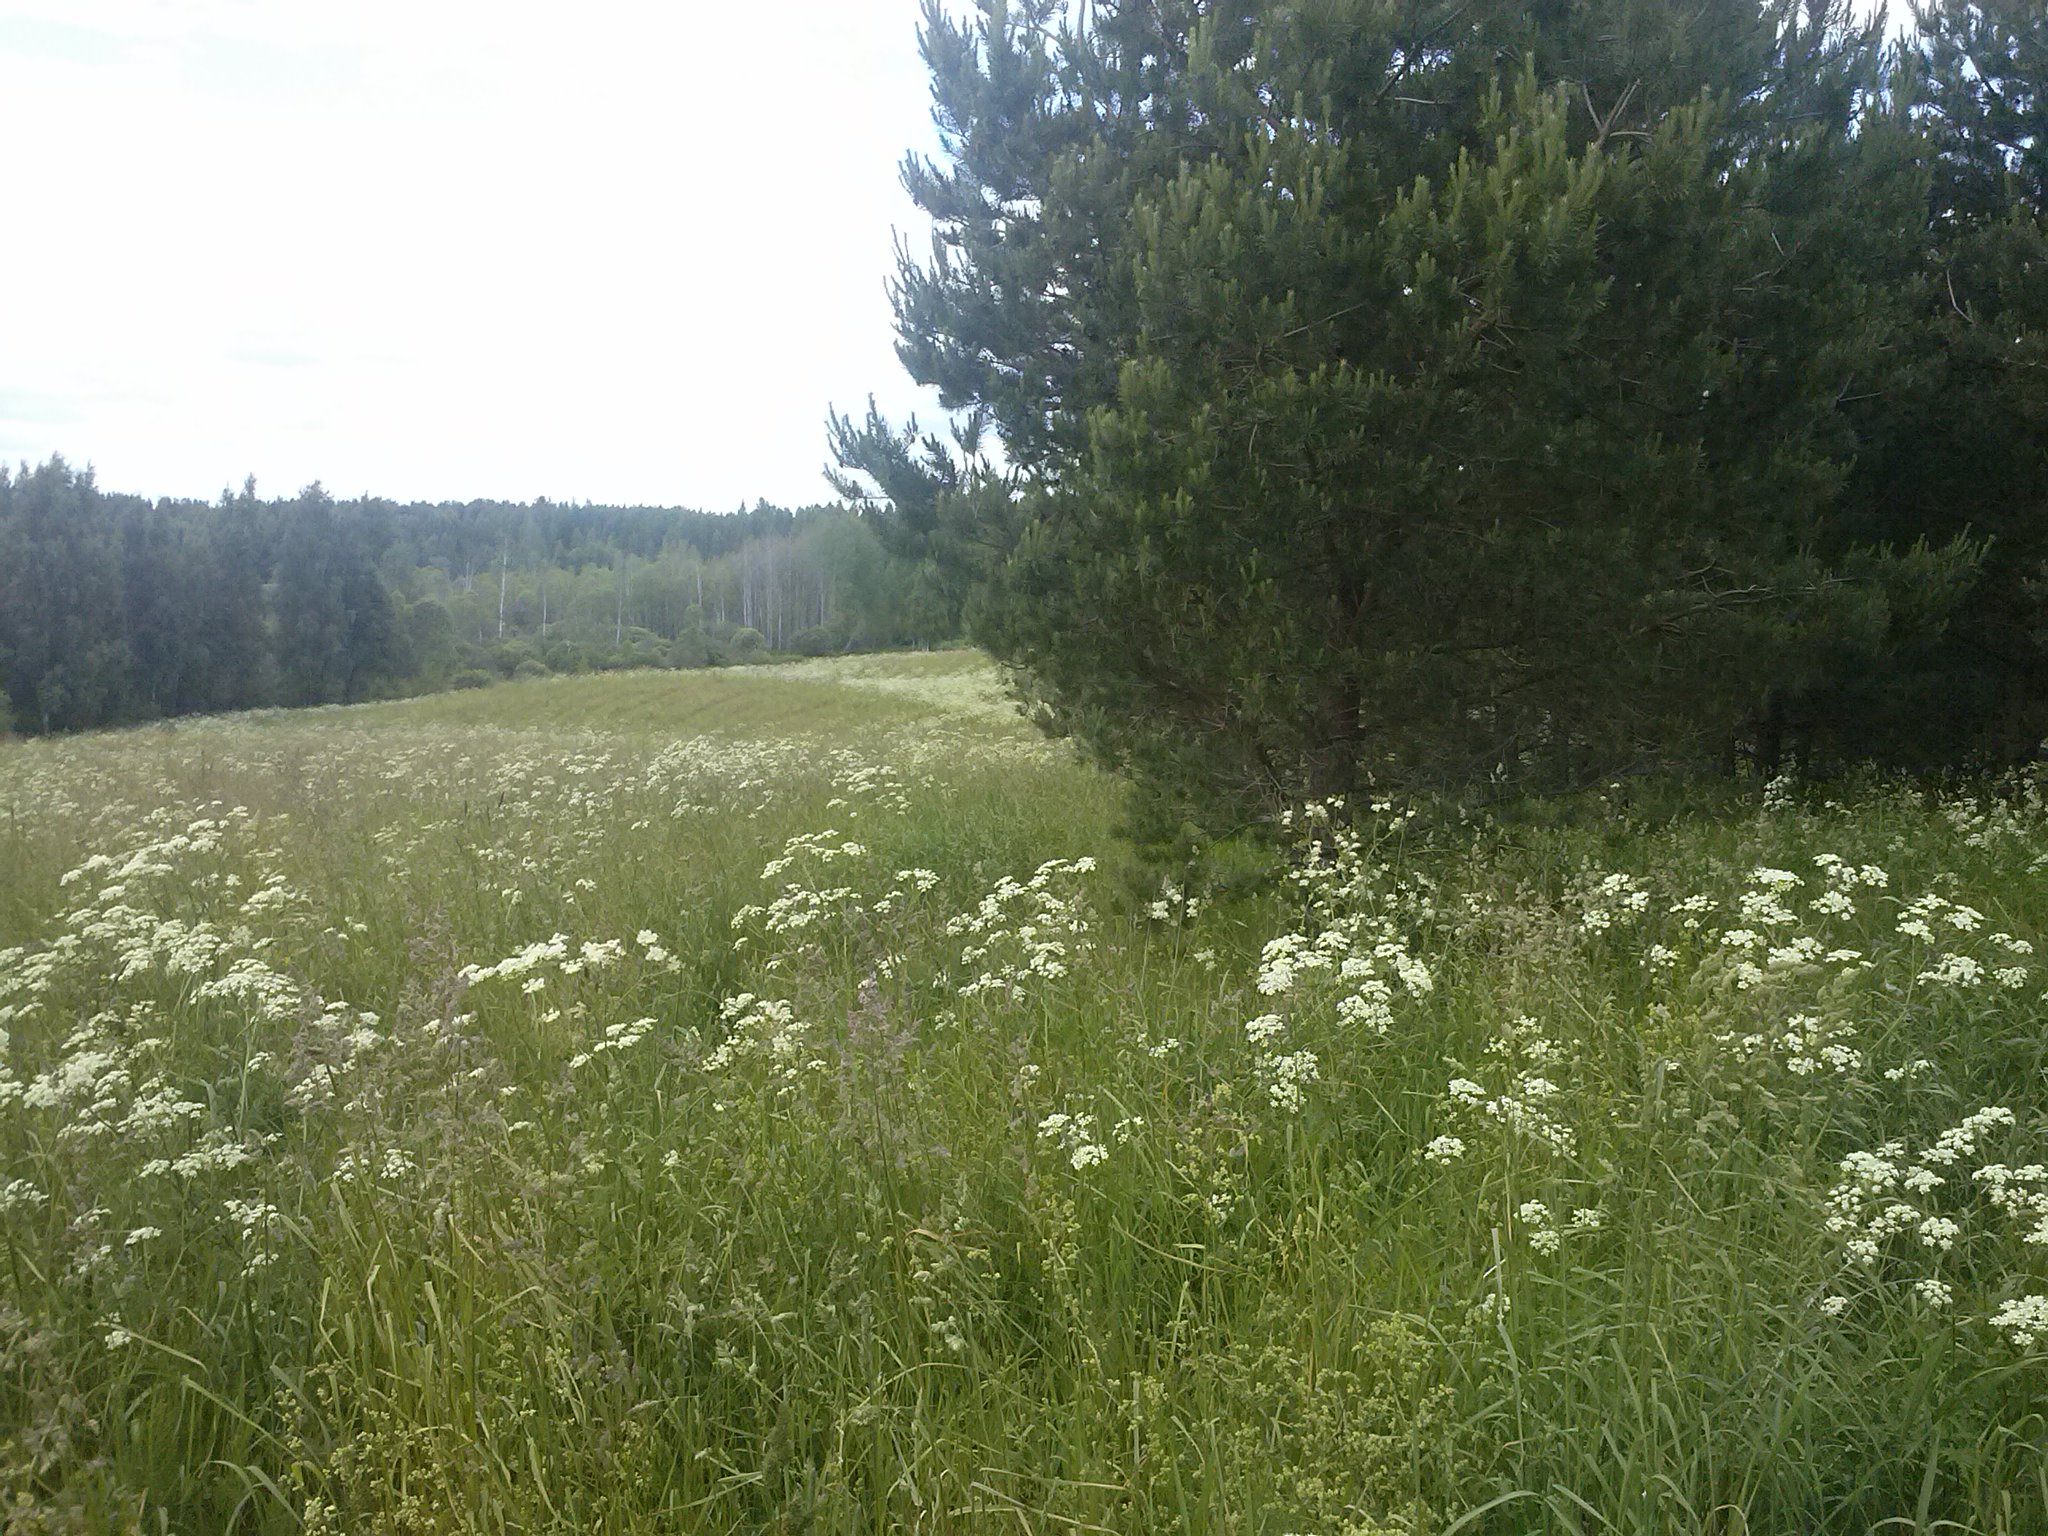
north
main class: Grassland
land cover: Grassland with sparse tree/shrub cover
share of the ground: > 75 %
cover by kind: herbaceous plants 85 %, shrubs 10 %, coniferous forest trees 5 %
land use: Semi-natural and natural areas not in use
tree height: < 5 m
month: June
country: LV
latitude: 56.4696
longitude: 27.8690
